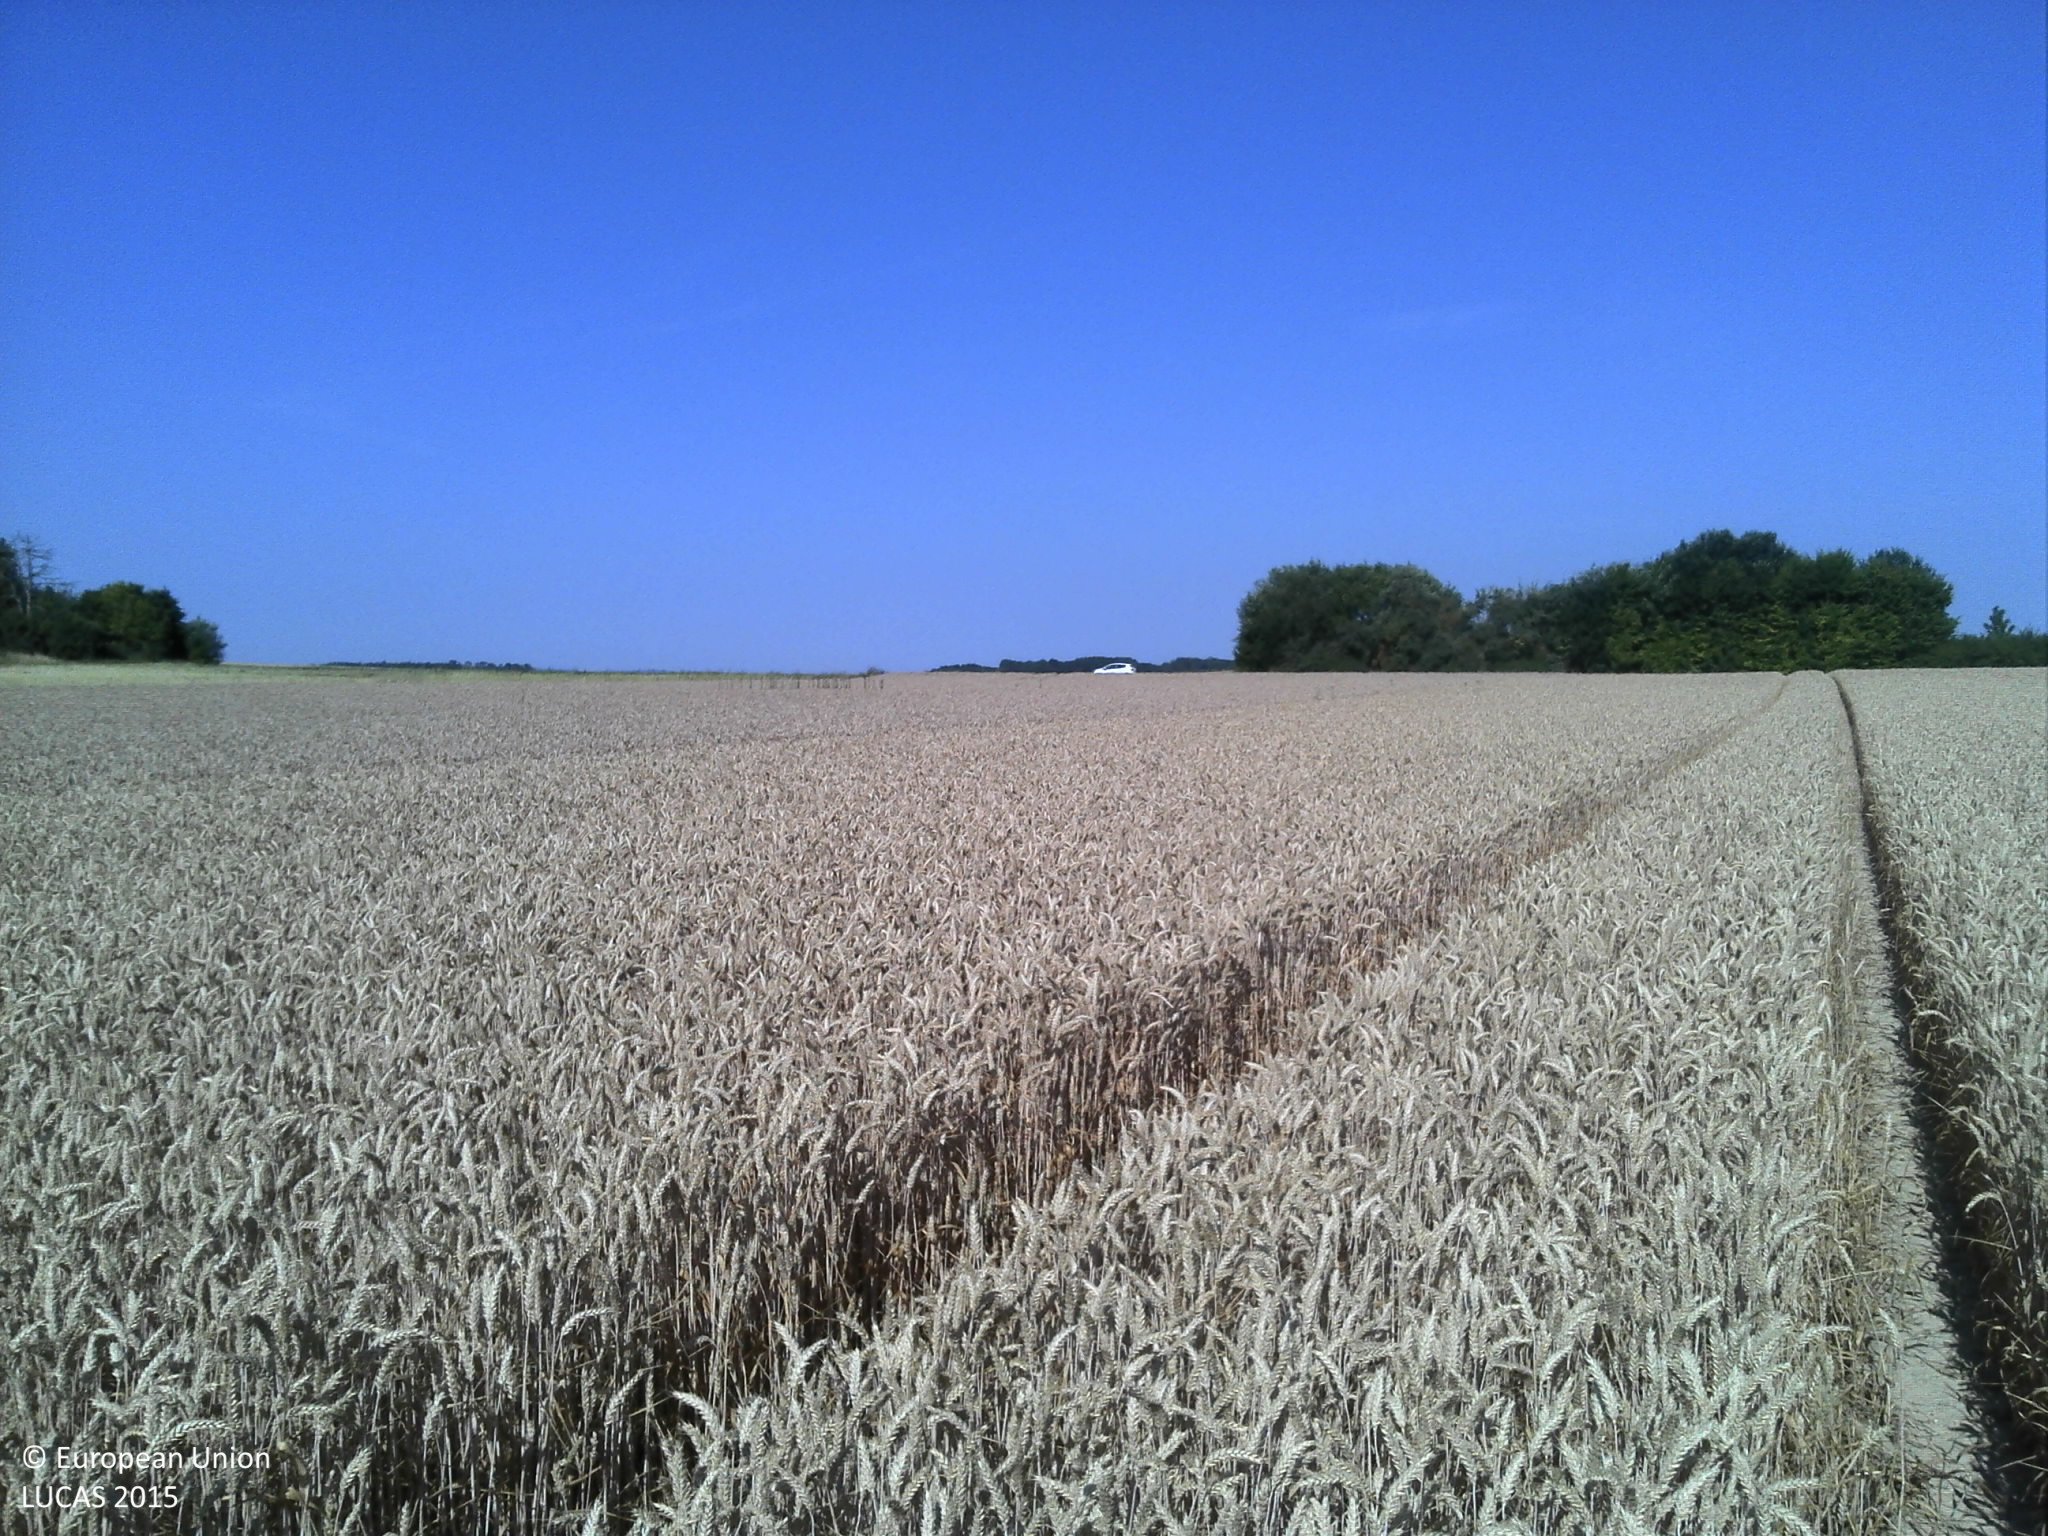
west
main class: Cropland
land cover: Common wheat
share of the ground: > 75 %
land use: Agriculture (excluding fallow land and kitchen gardens)
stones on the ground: < 10 %
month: July
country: FR
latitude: 49.4217
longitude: 4.1638
